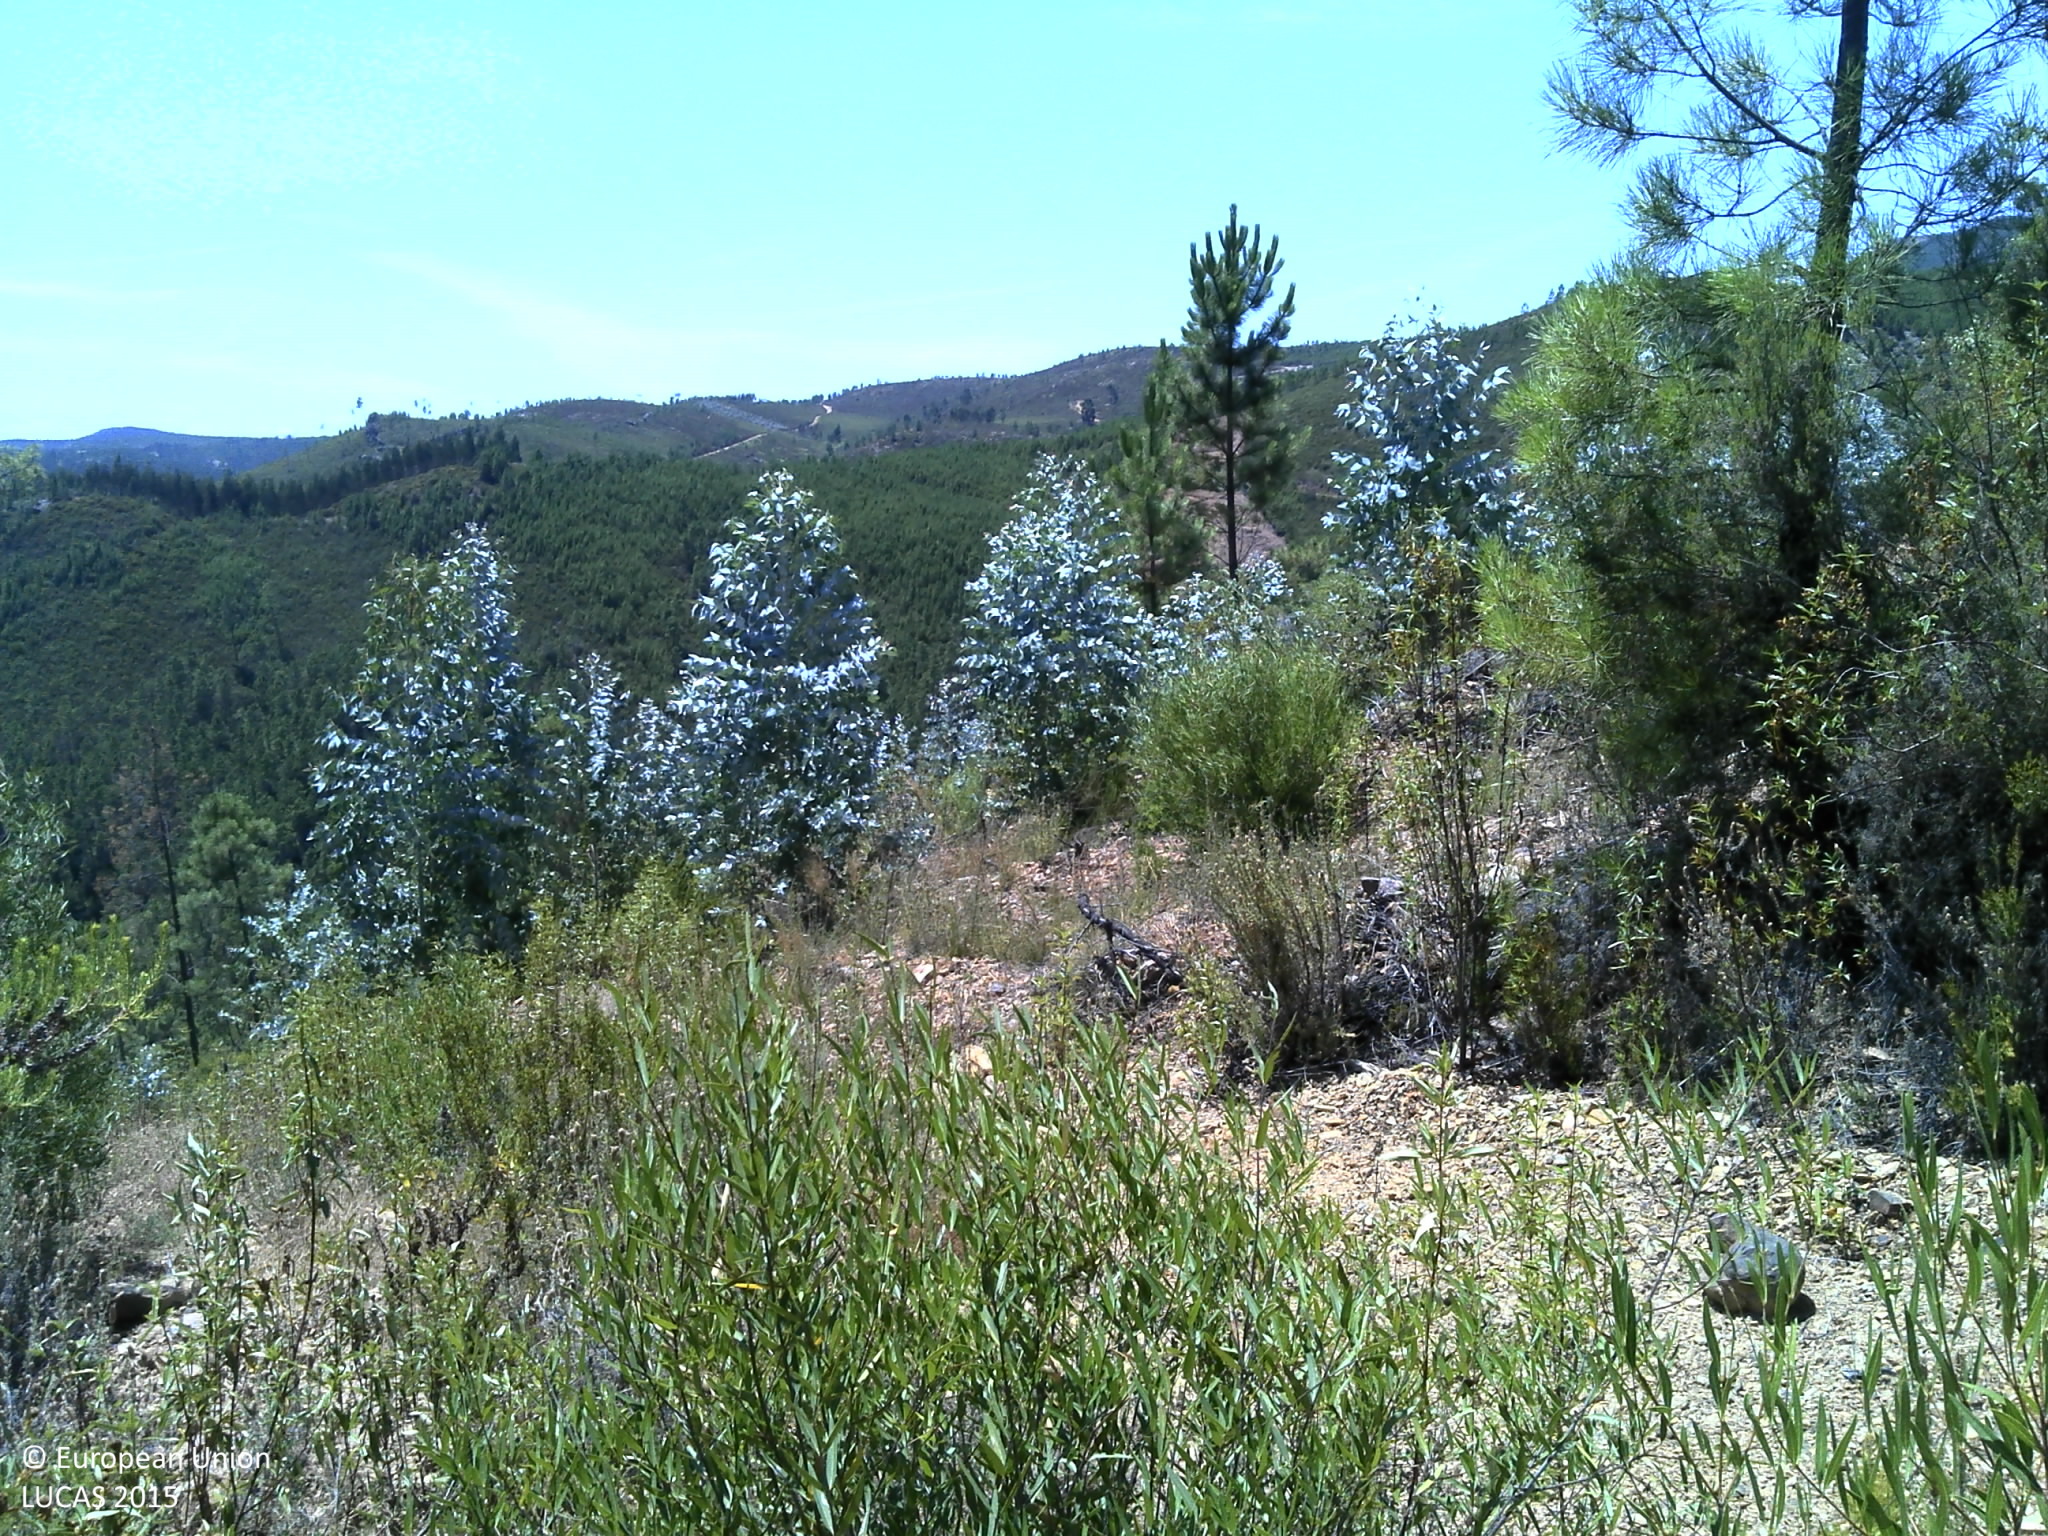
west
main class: Shrubland
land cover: Shrubland with sparse tree cover
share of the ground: > 75 %
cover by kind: shrubs 80 %, unconsolidated bare surface 15 %, coniferous forest trees 5 %
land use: Semi-natural and natural areas not in use
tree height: > 5 m
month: July
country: PT
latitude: 39.5972
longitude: -7.9347
